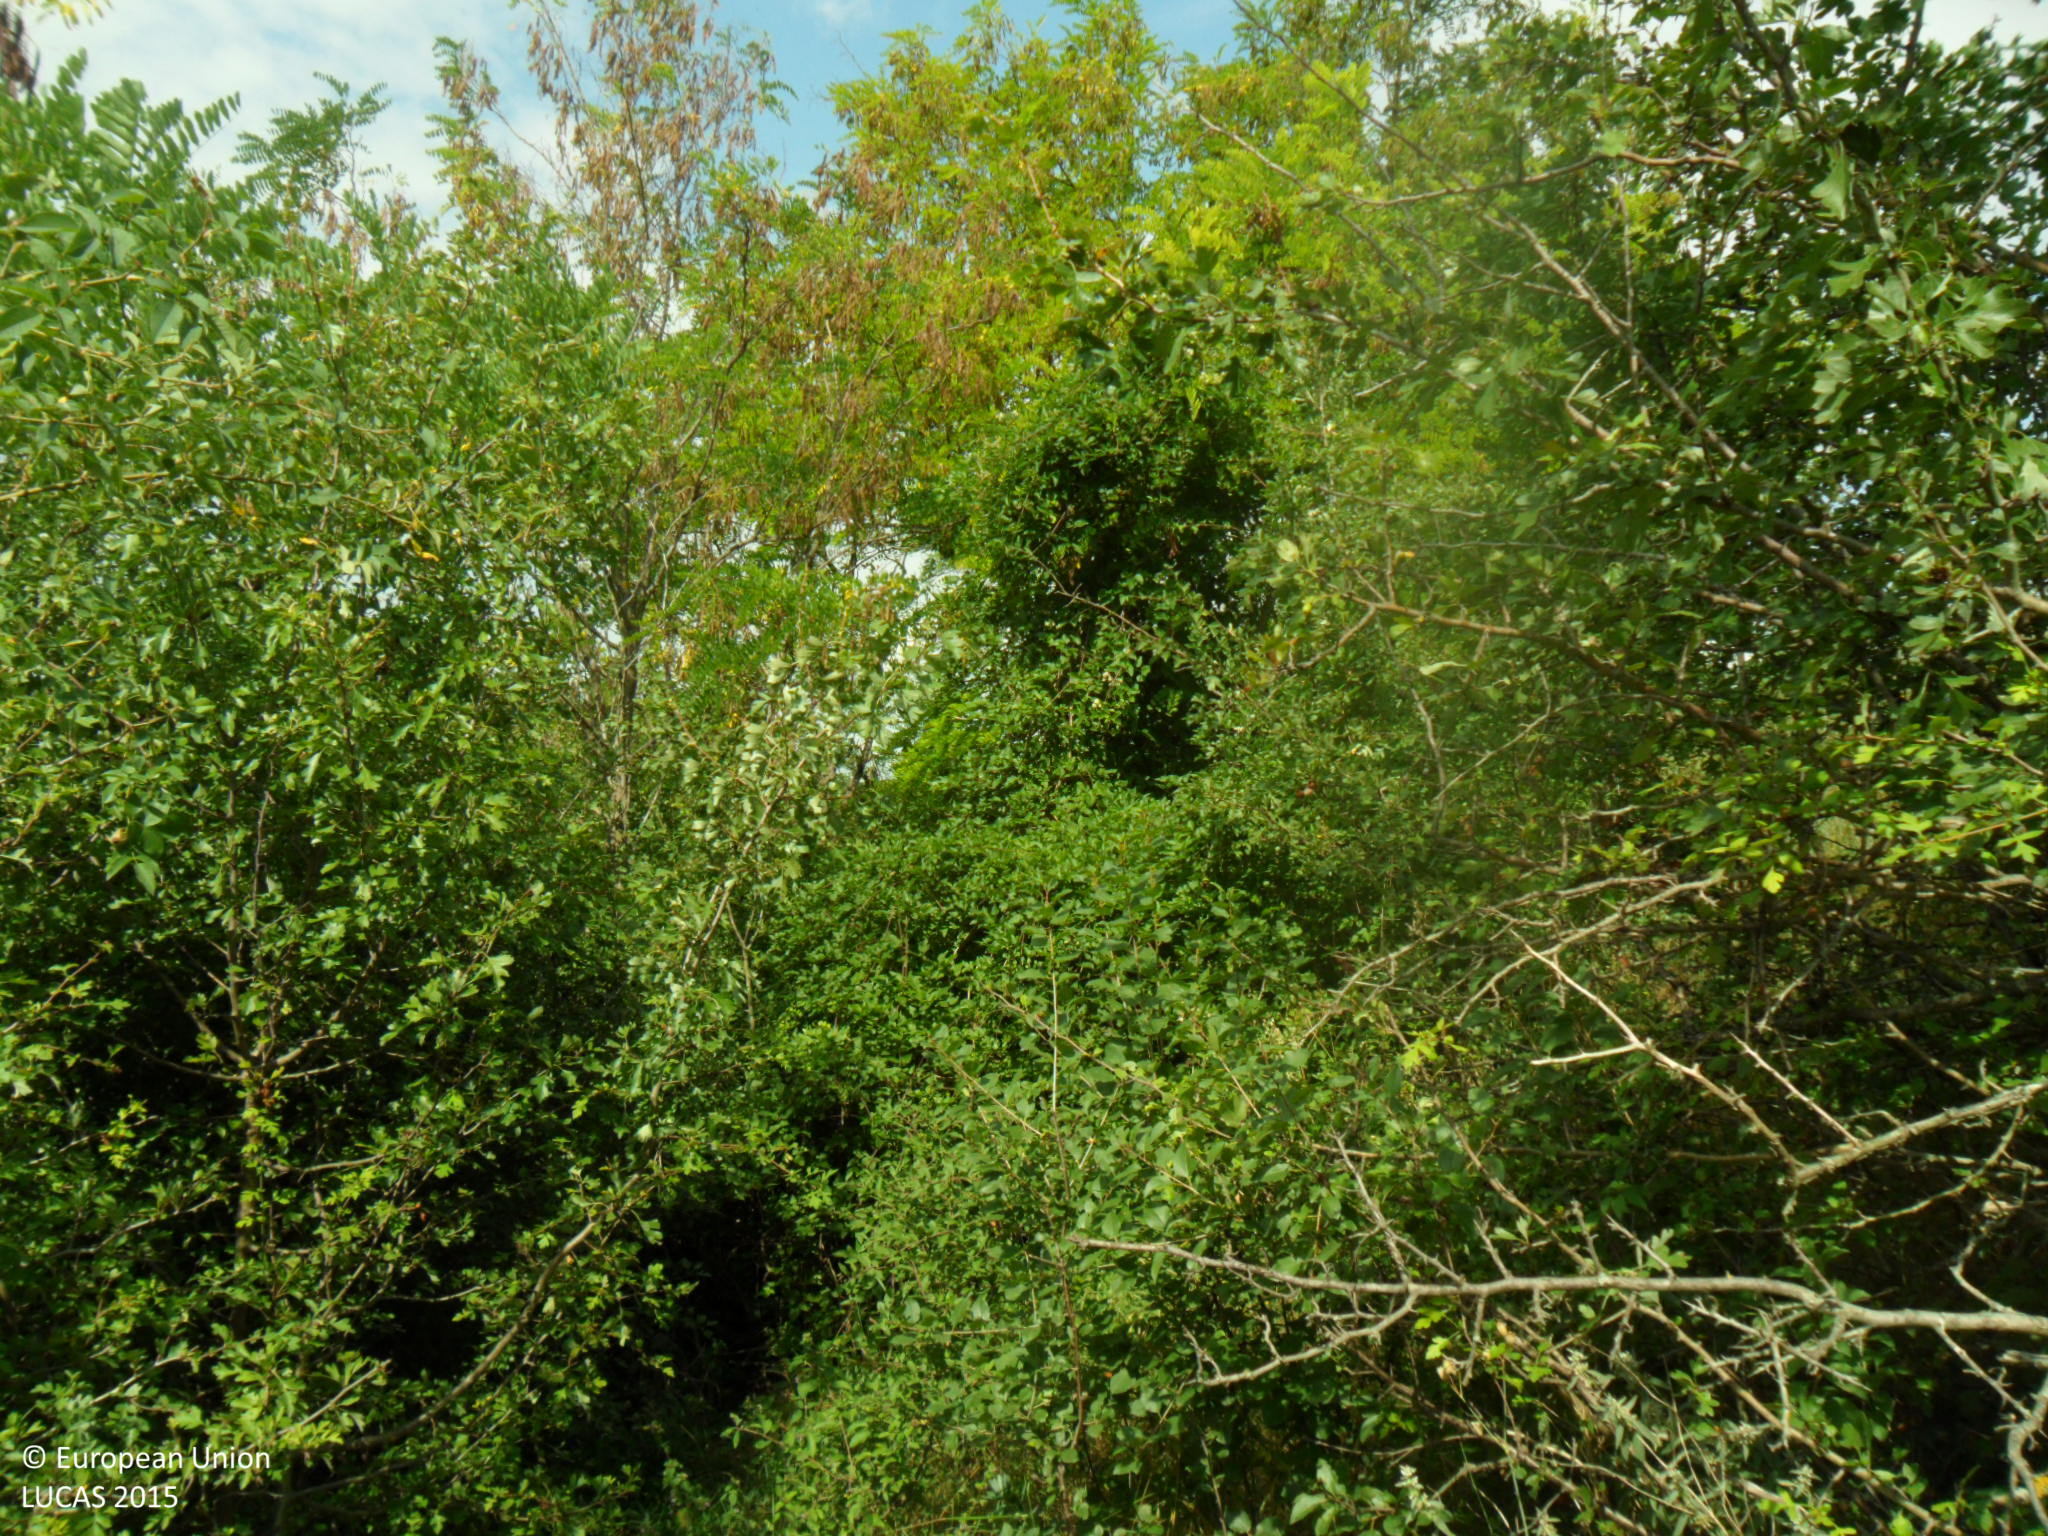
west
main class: Shrubland
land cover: Shrubland with sparse tree cover
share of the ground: > 75 %
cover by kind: shrubs 90 %, broadleaved forest trees 5 %, herbaceous plants 5 %
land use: Semi-natural and natural areas not in use
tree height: < 5 m
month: July
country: BG
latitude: 43.3812
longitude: 27.1919
